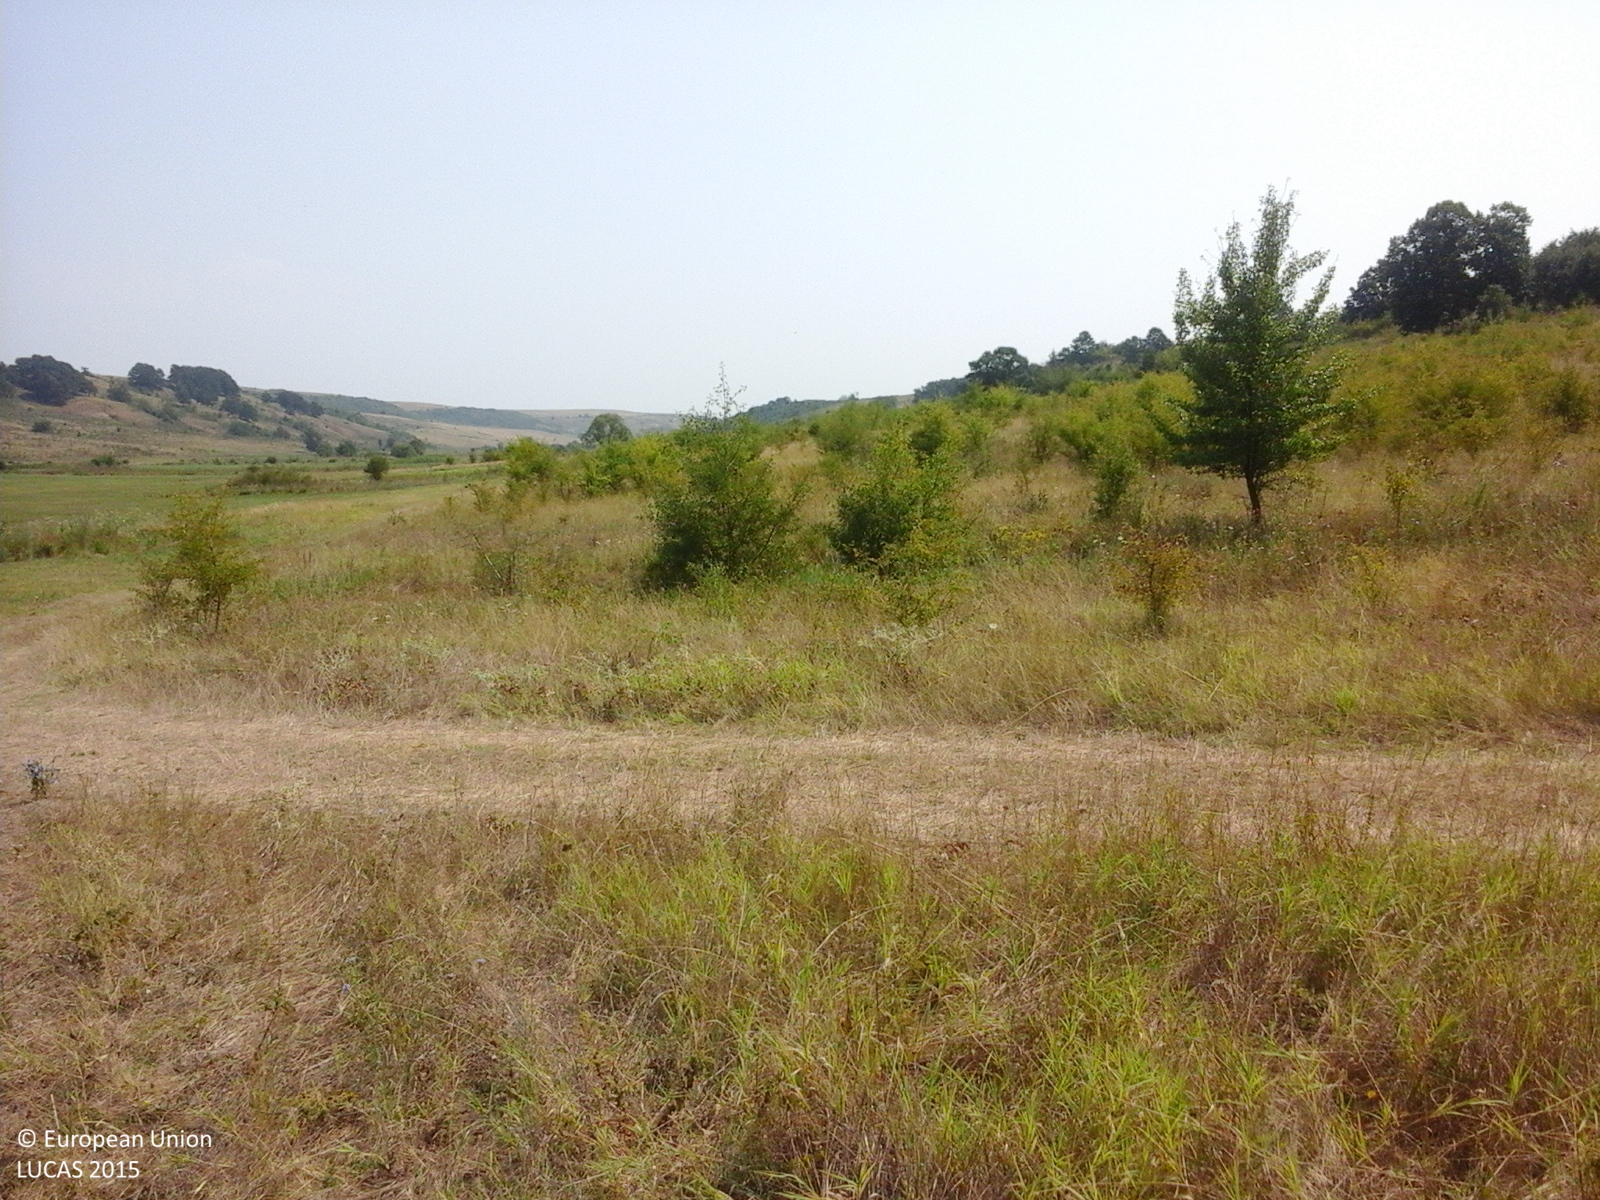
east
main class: Grassland
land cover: Spontaneously vegetated surfaces
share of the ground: > 75 %
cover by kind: herbaceous plants 100 %
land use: Fallow land
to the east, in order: Spontaneously vegetated surfaces; Tracks; Grassland with sparse tree/shrub cover; Shrubland with sparse tree cover; Grassland with sparse tree/shrub cover
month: August
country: RO
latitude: 44.3762
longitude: 23.3662
